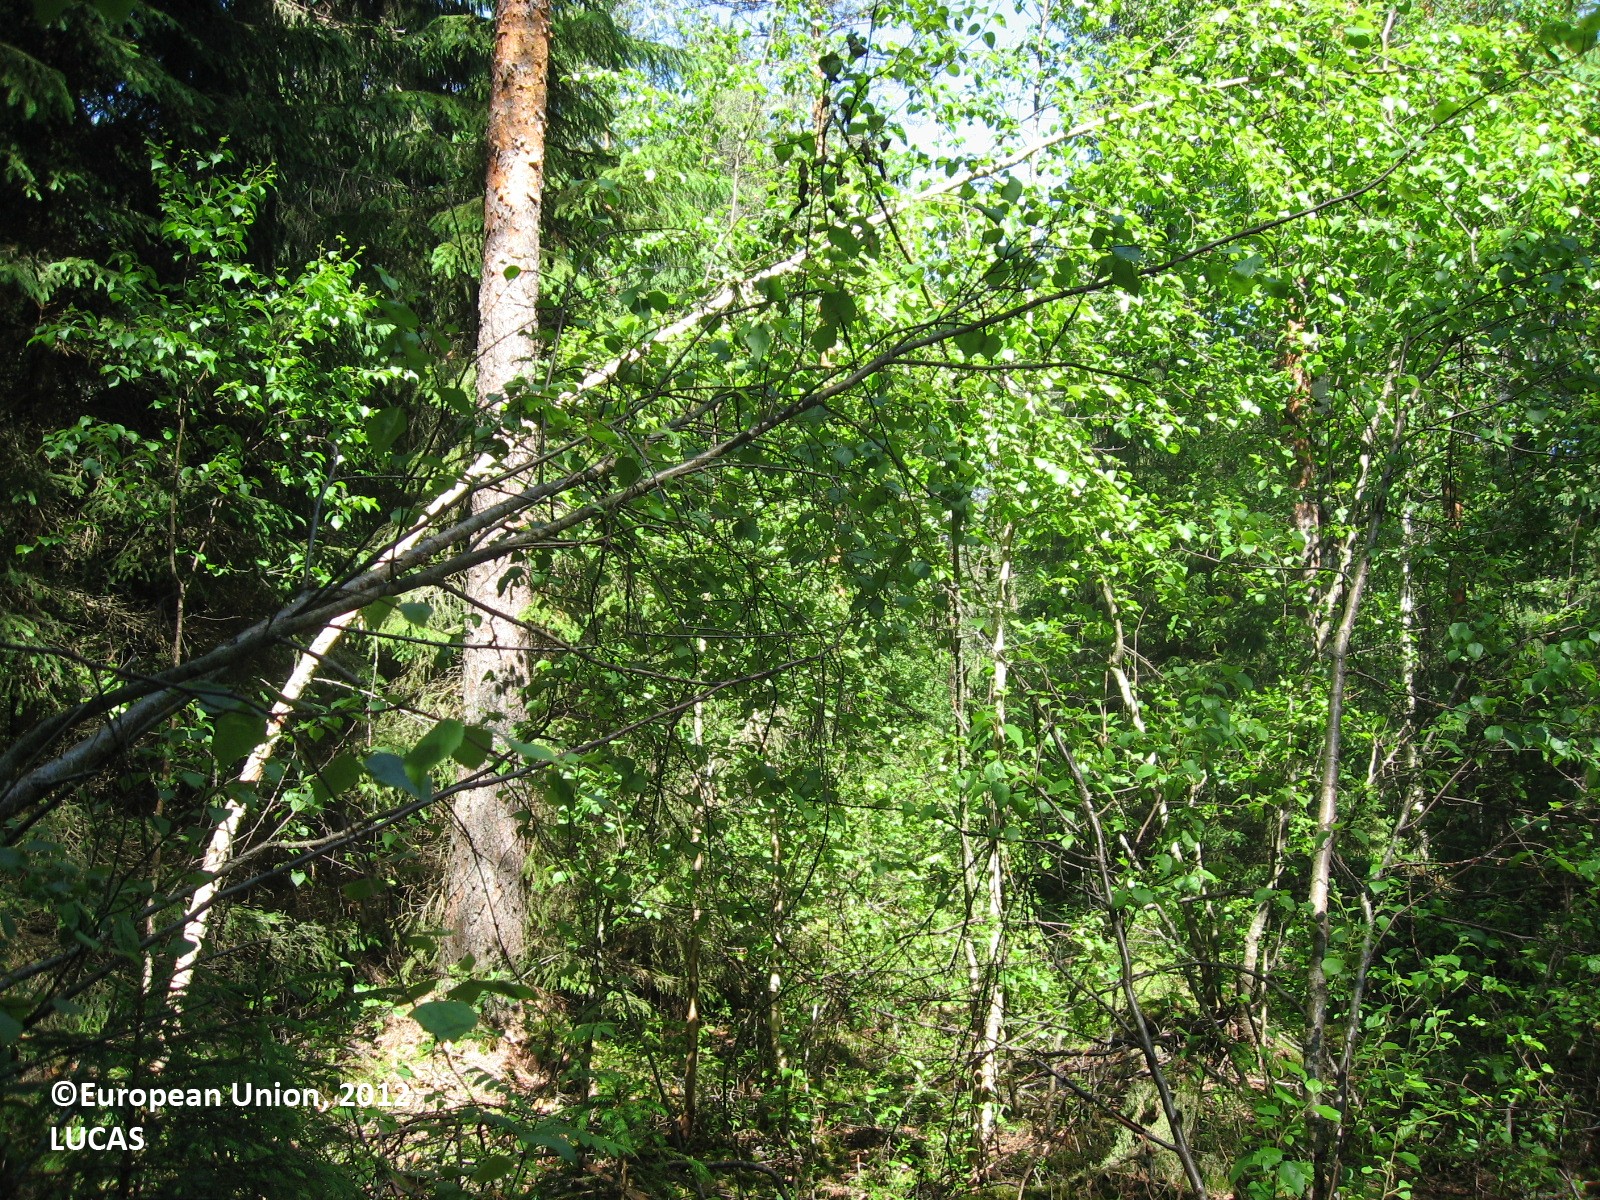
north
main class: Woodland
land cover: Other coniferous woodland
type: boreal forest
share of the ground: 50 - 75 %
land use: Forestry
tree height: > 5 m
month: June
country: FI
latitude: 60.5266
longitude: 26.3495
